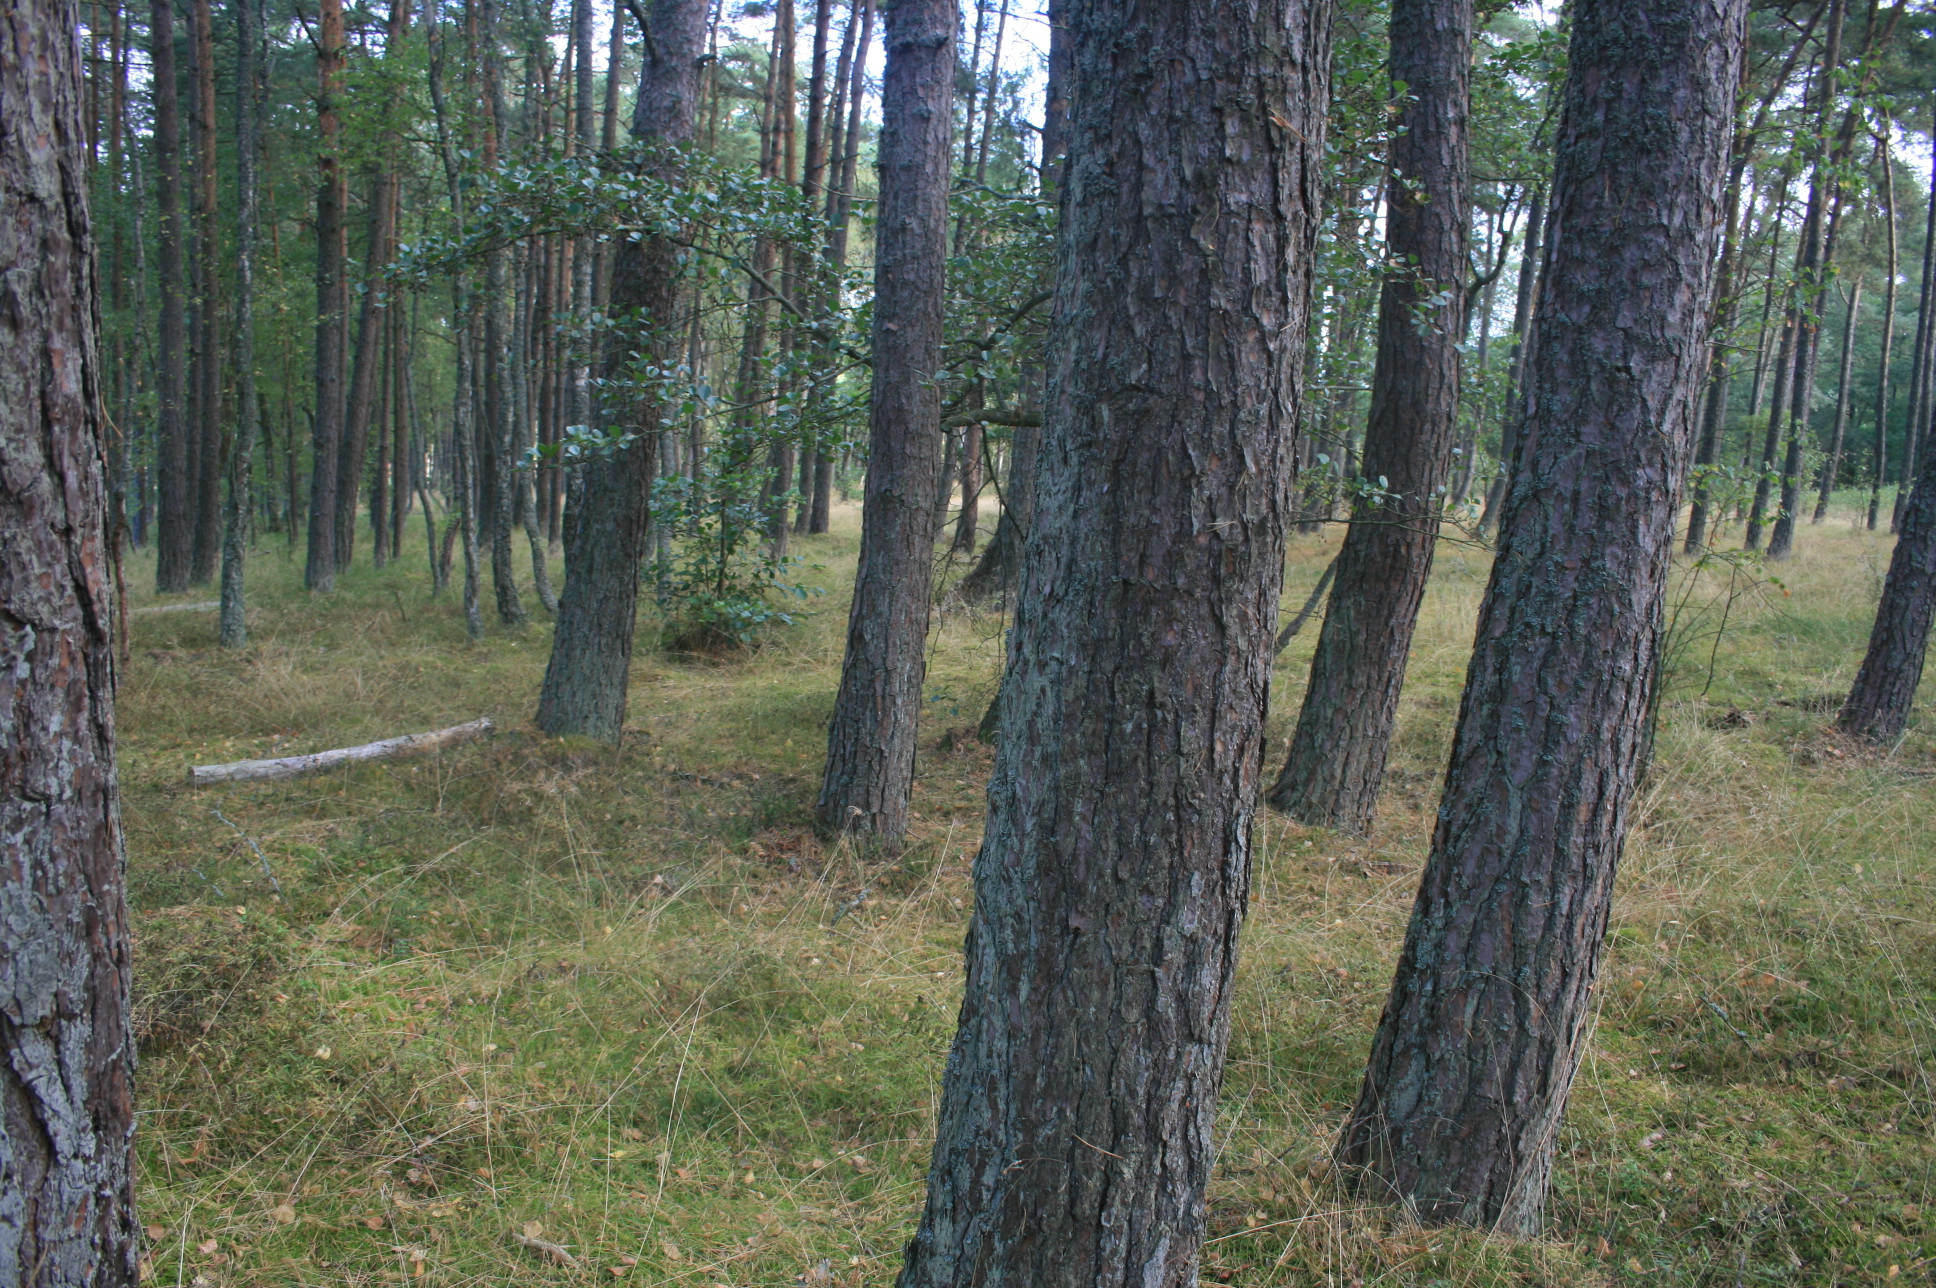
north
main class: Woodland
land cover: Pine dominated coniferous woodland
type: hemiboreal forest and nemoral coniferous forest and mixed broadleaved-coniferous forest
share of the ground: > 75 %
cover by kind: coniferous forest trees 80 %, herbaceous plants 10 %, lichens and mosses 10 %
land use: Forestry
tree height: > 5 m
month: September
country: LT
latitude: 55.3978
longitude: 21.0775
